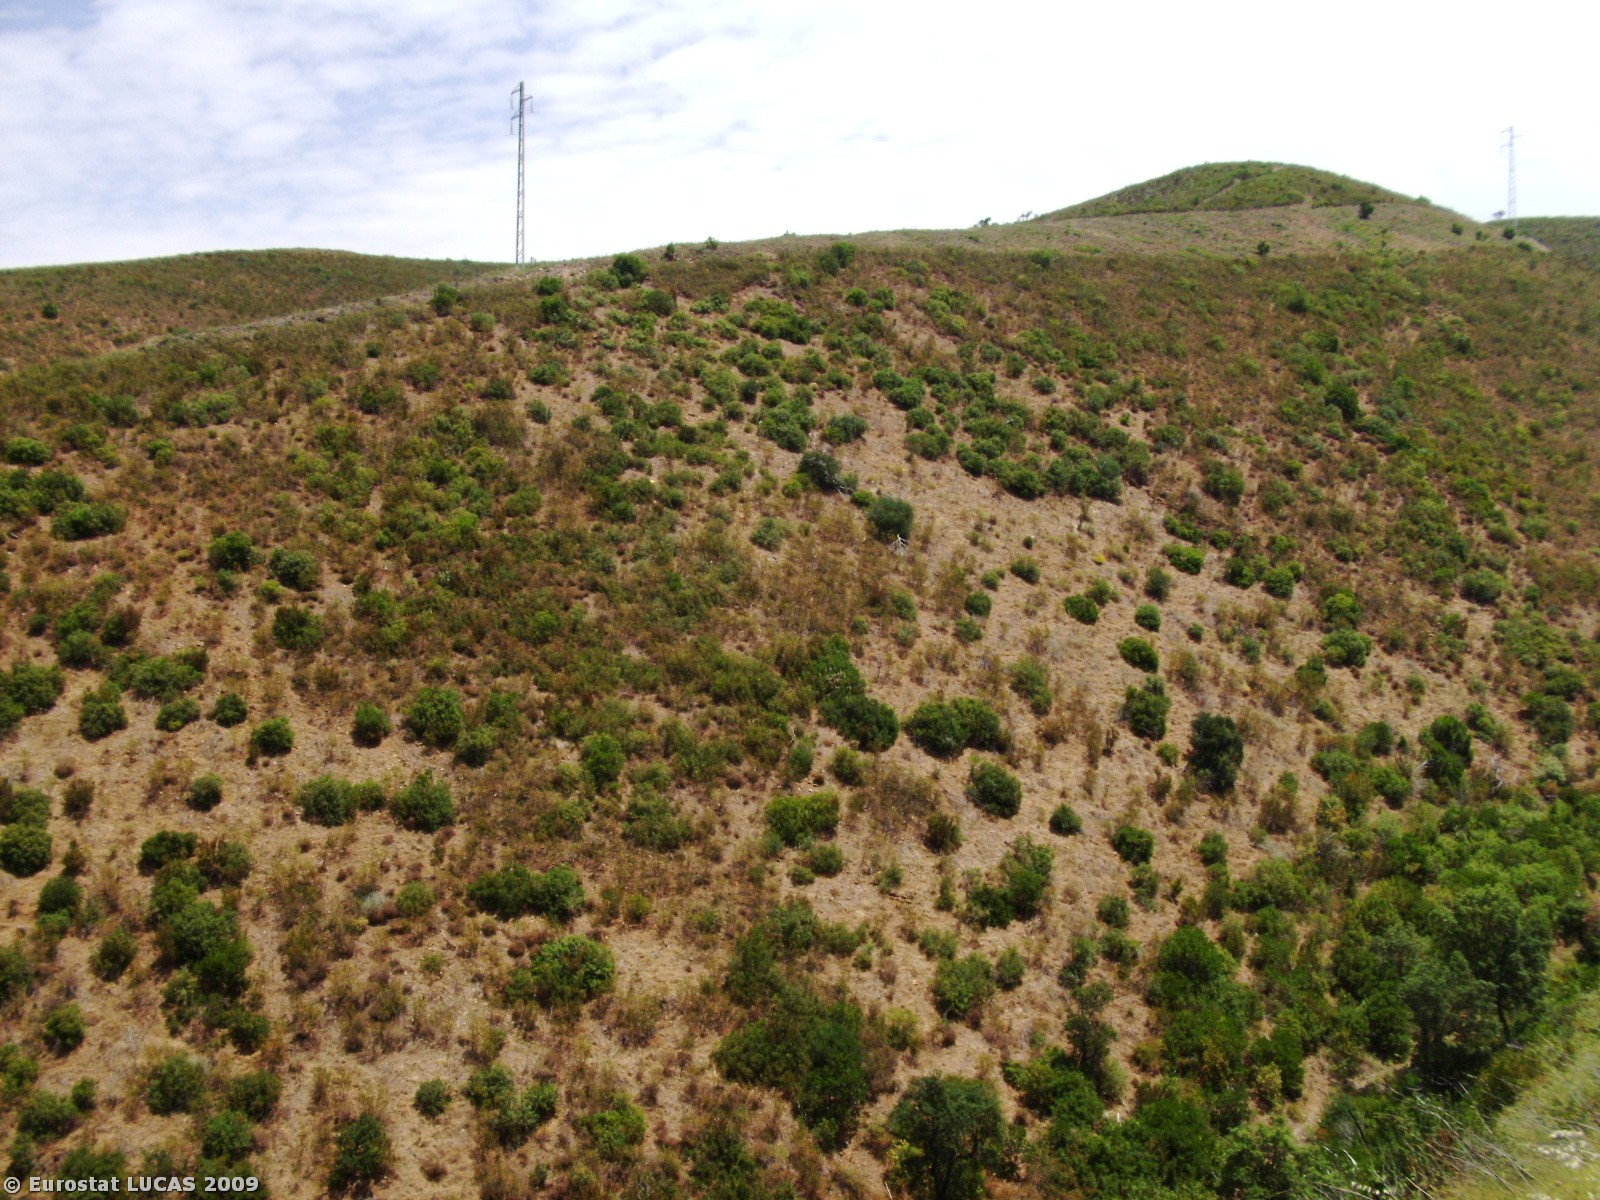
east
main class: Shrubland
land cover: Shrubland with sparse tree cover
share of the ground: > 75 %
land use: Nature reserves
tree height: < 5 m
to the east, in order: Shrubland with sparse tree cover; Tracks; Shrubland with sparse tree cover; Electric lines; Shrubland with sparse tree cover
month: June
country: PT
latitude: 37.3104
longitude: -8.7533
